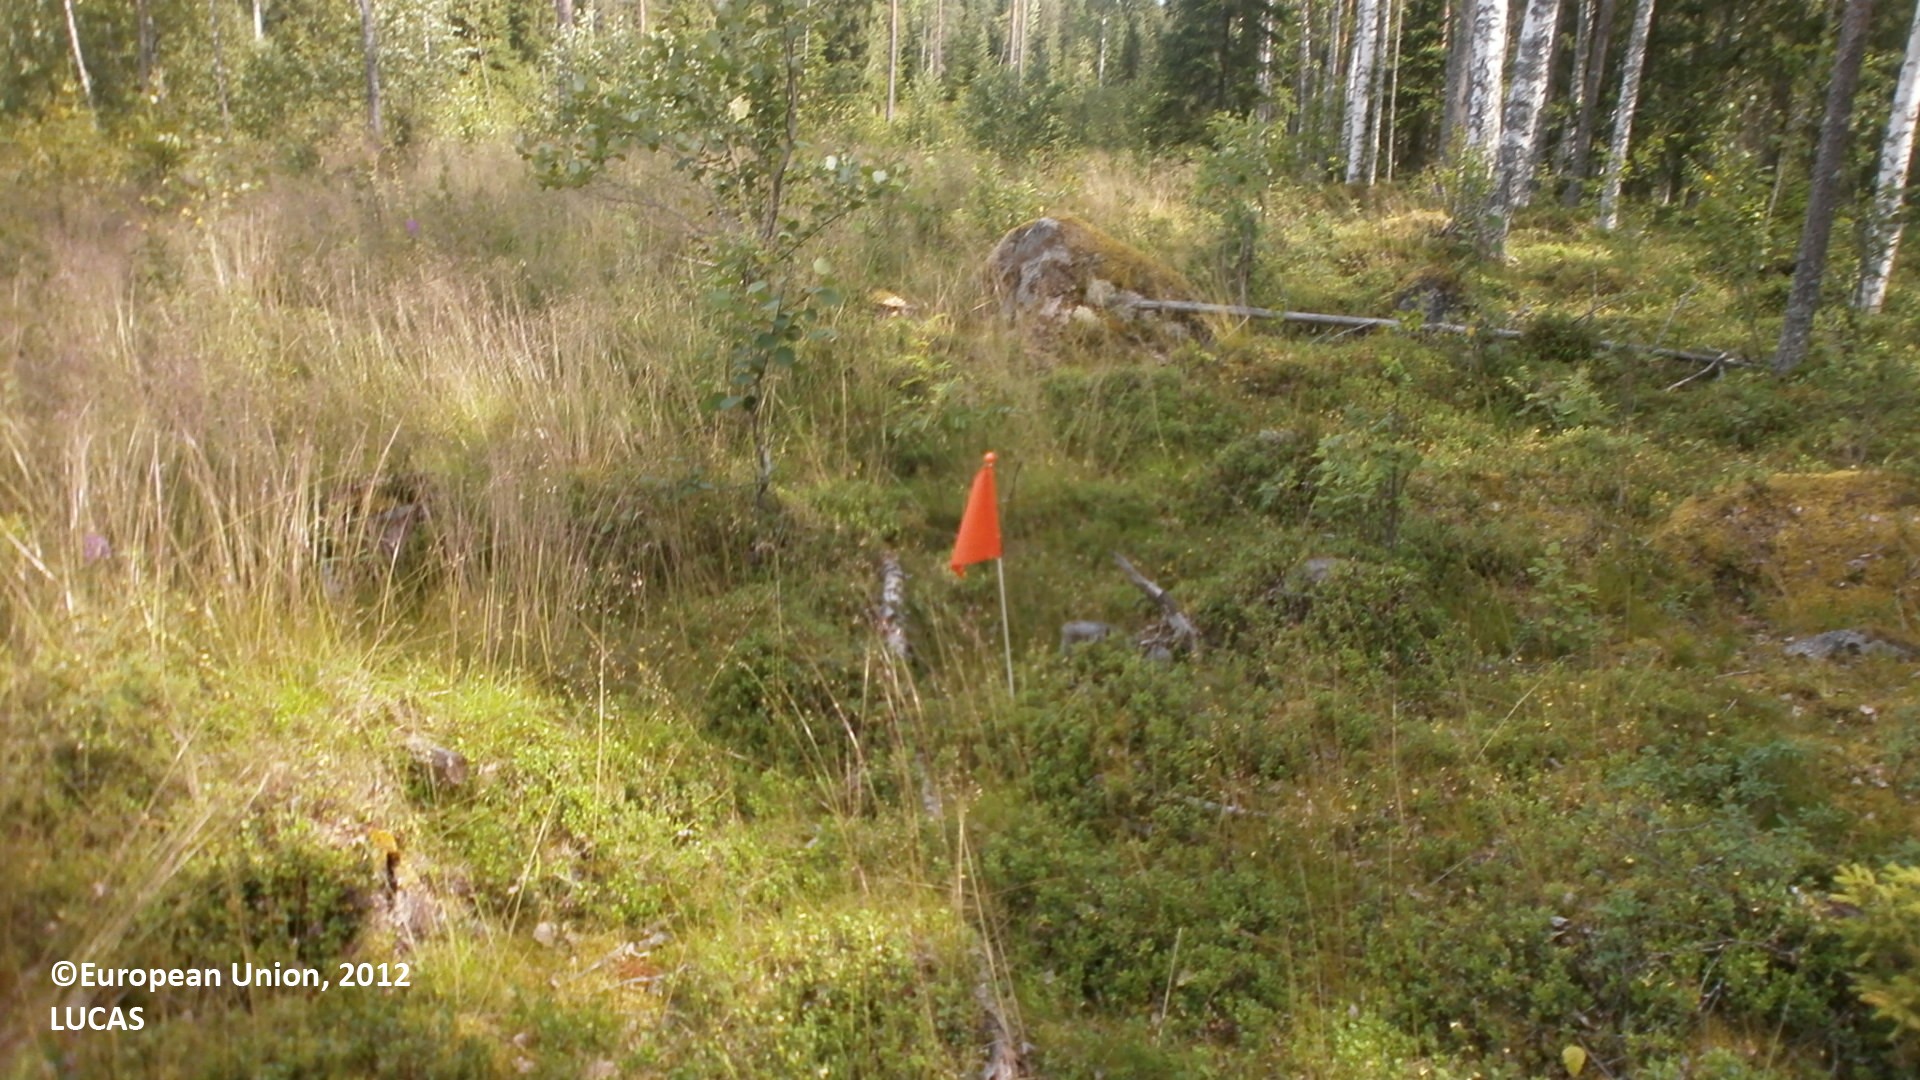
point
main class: Shrubland
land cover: Shrubland with sparse tree cover
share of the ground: > 75 %
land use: Forestry
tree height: < 5 m
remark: Clear cut
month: July
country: FI
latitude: 64.0443
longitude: 24.2611
